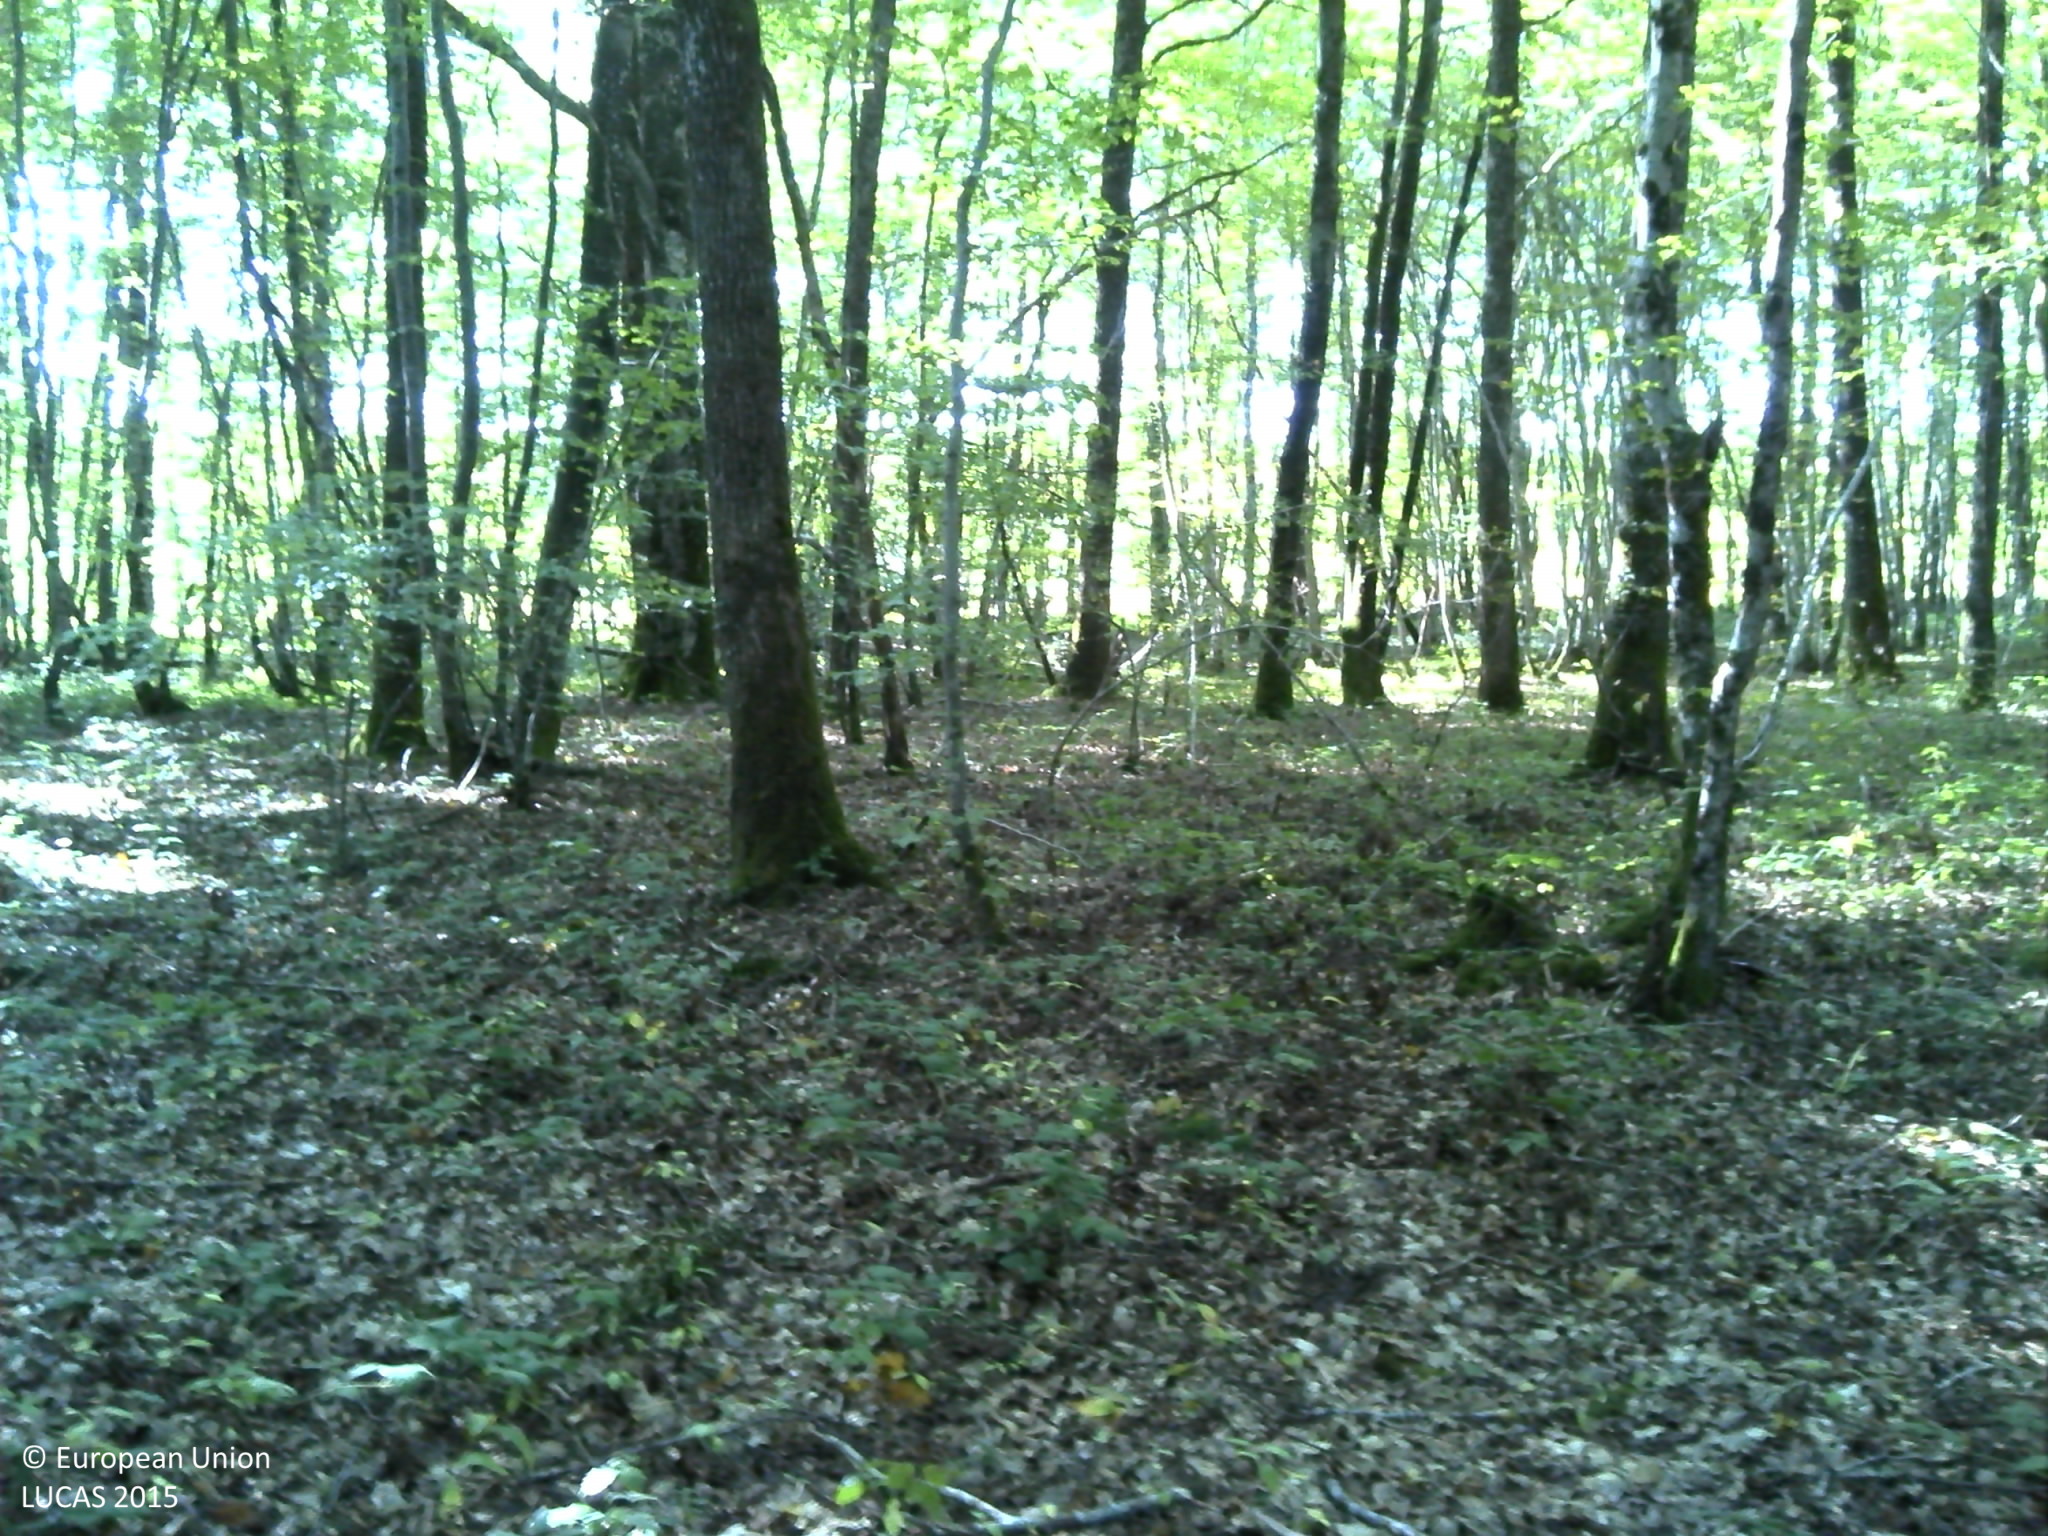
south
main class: Woodland
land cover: Broadleaved woodland
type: mesophytic deciduous forest
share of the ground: > 75 %
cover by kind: broadleaved forest trees 85 %, herbaceous plants 10 %, lichens and mosses 5 %
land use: Forestry
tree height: > 5 m
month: September
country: FR
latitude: 46.8736
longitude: 4.4242
